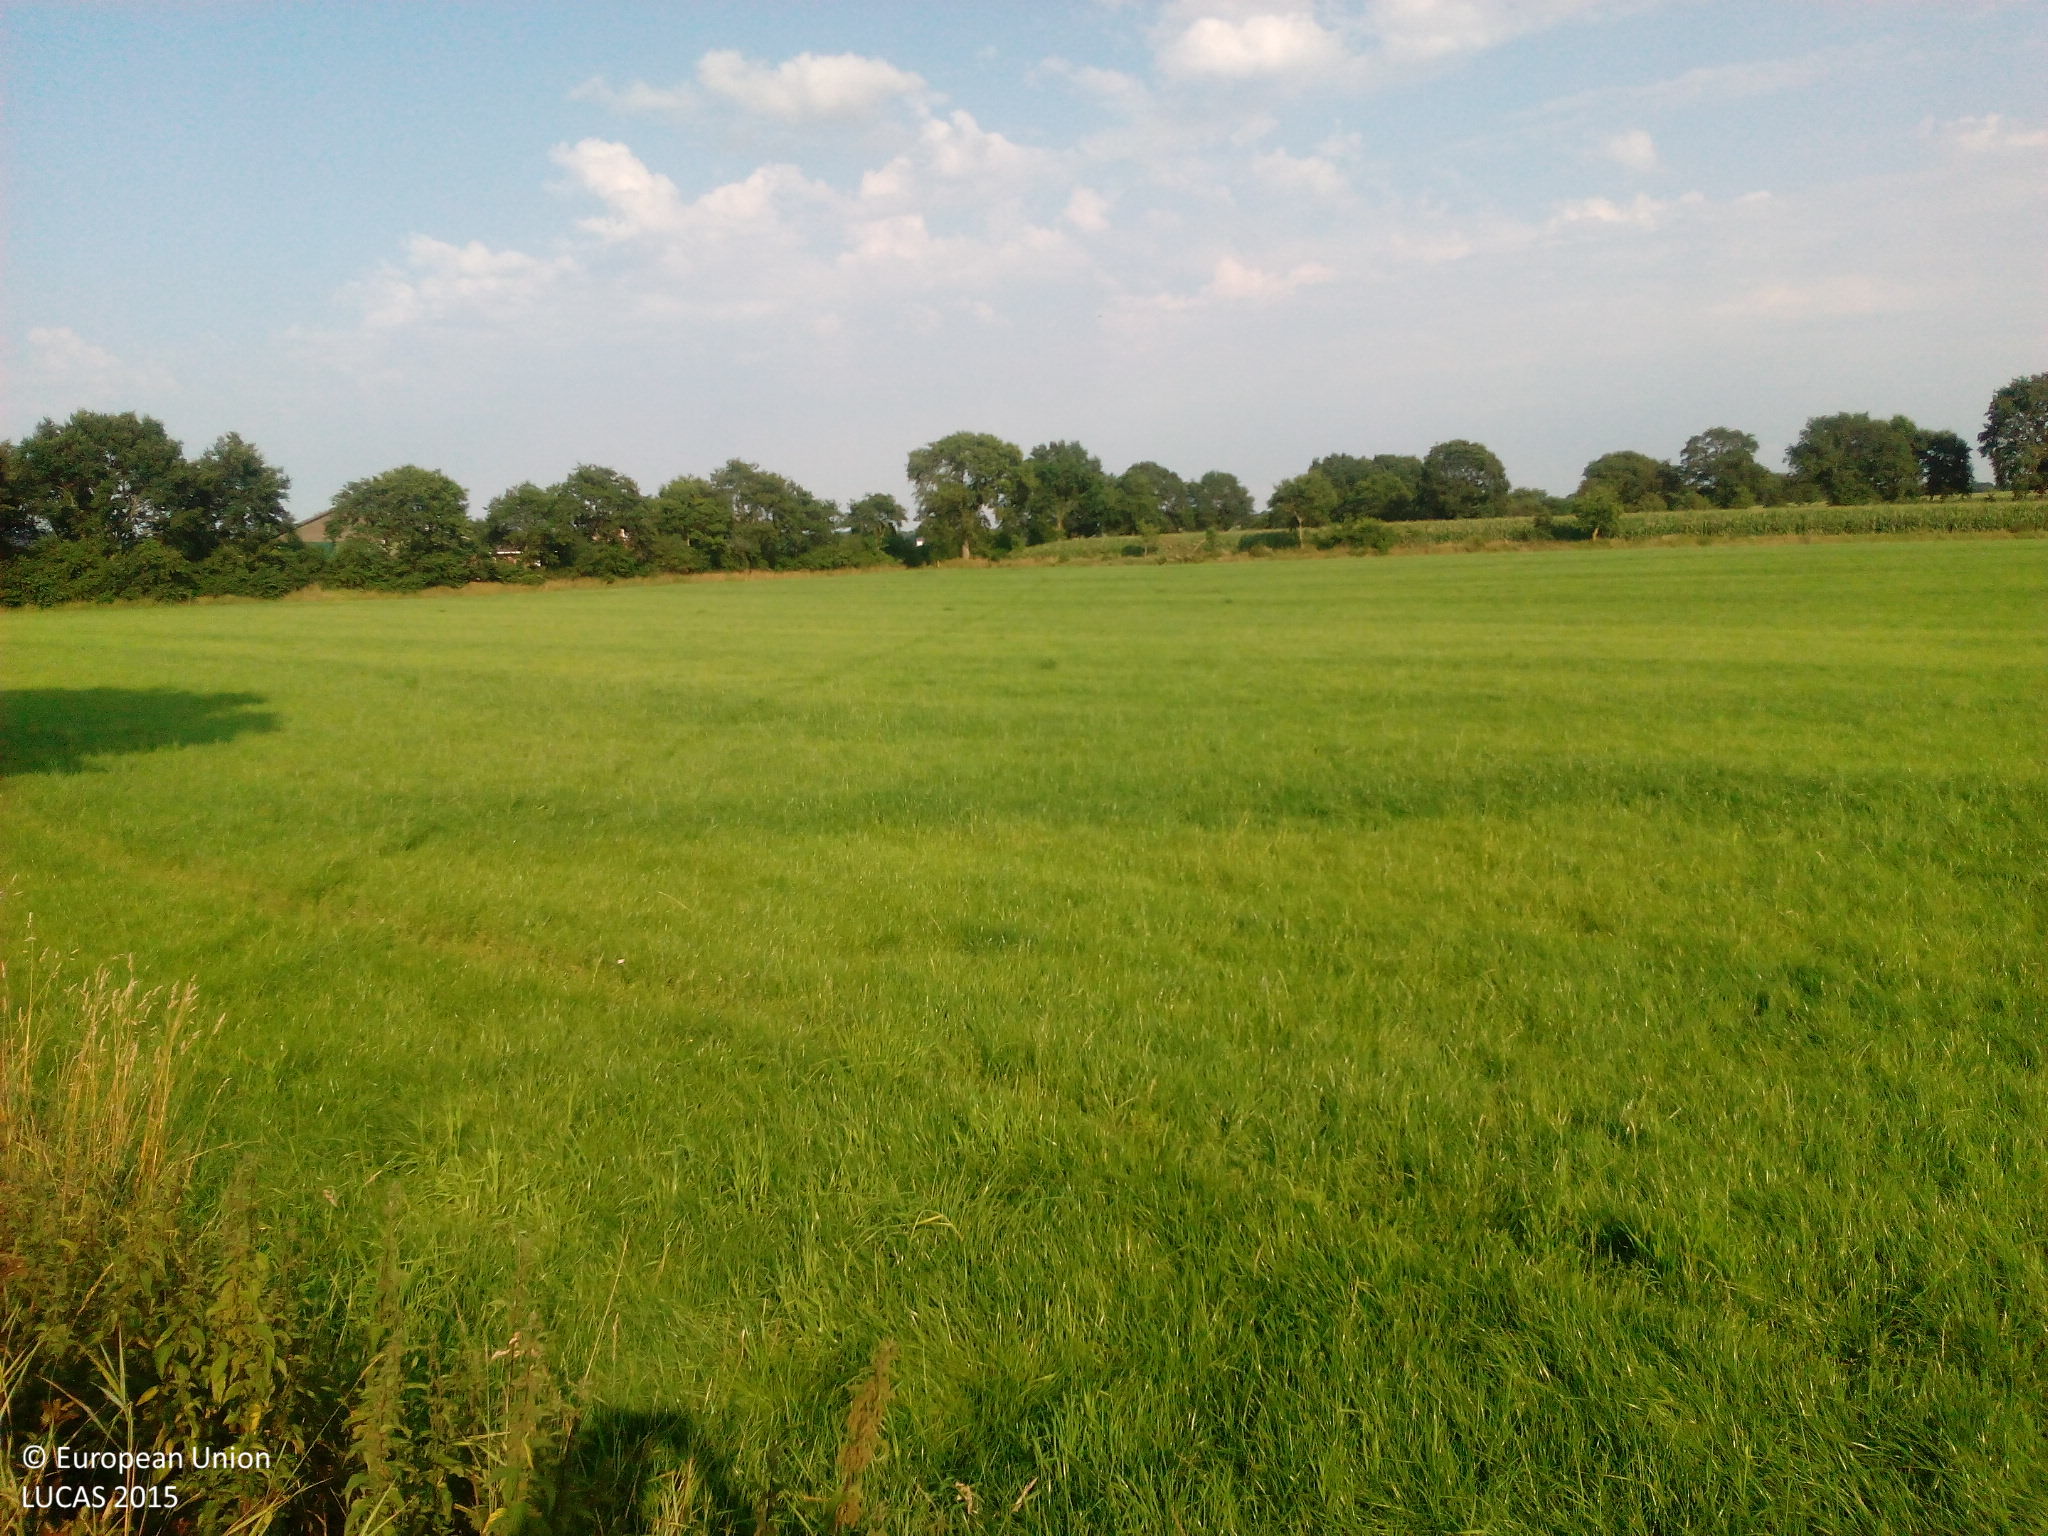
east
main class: Cropland
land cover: Maize
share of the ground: > 75 %
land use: Agriculture (excluding fallow land and kitchen gardens)
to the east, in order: Maize; Grassland with sparse tree/shrub cover; Grassland without tree/shrub cover
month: August
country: DE
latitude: 53.9923
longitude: 9.1921
